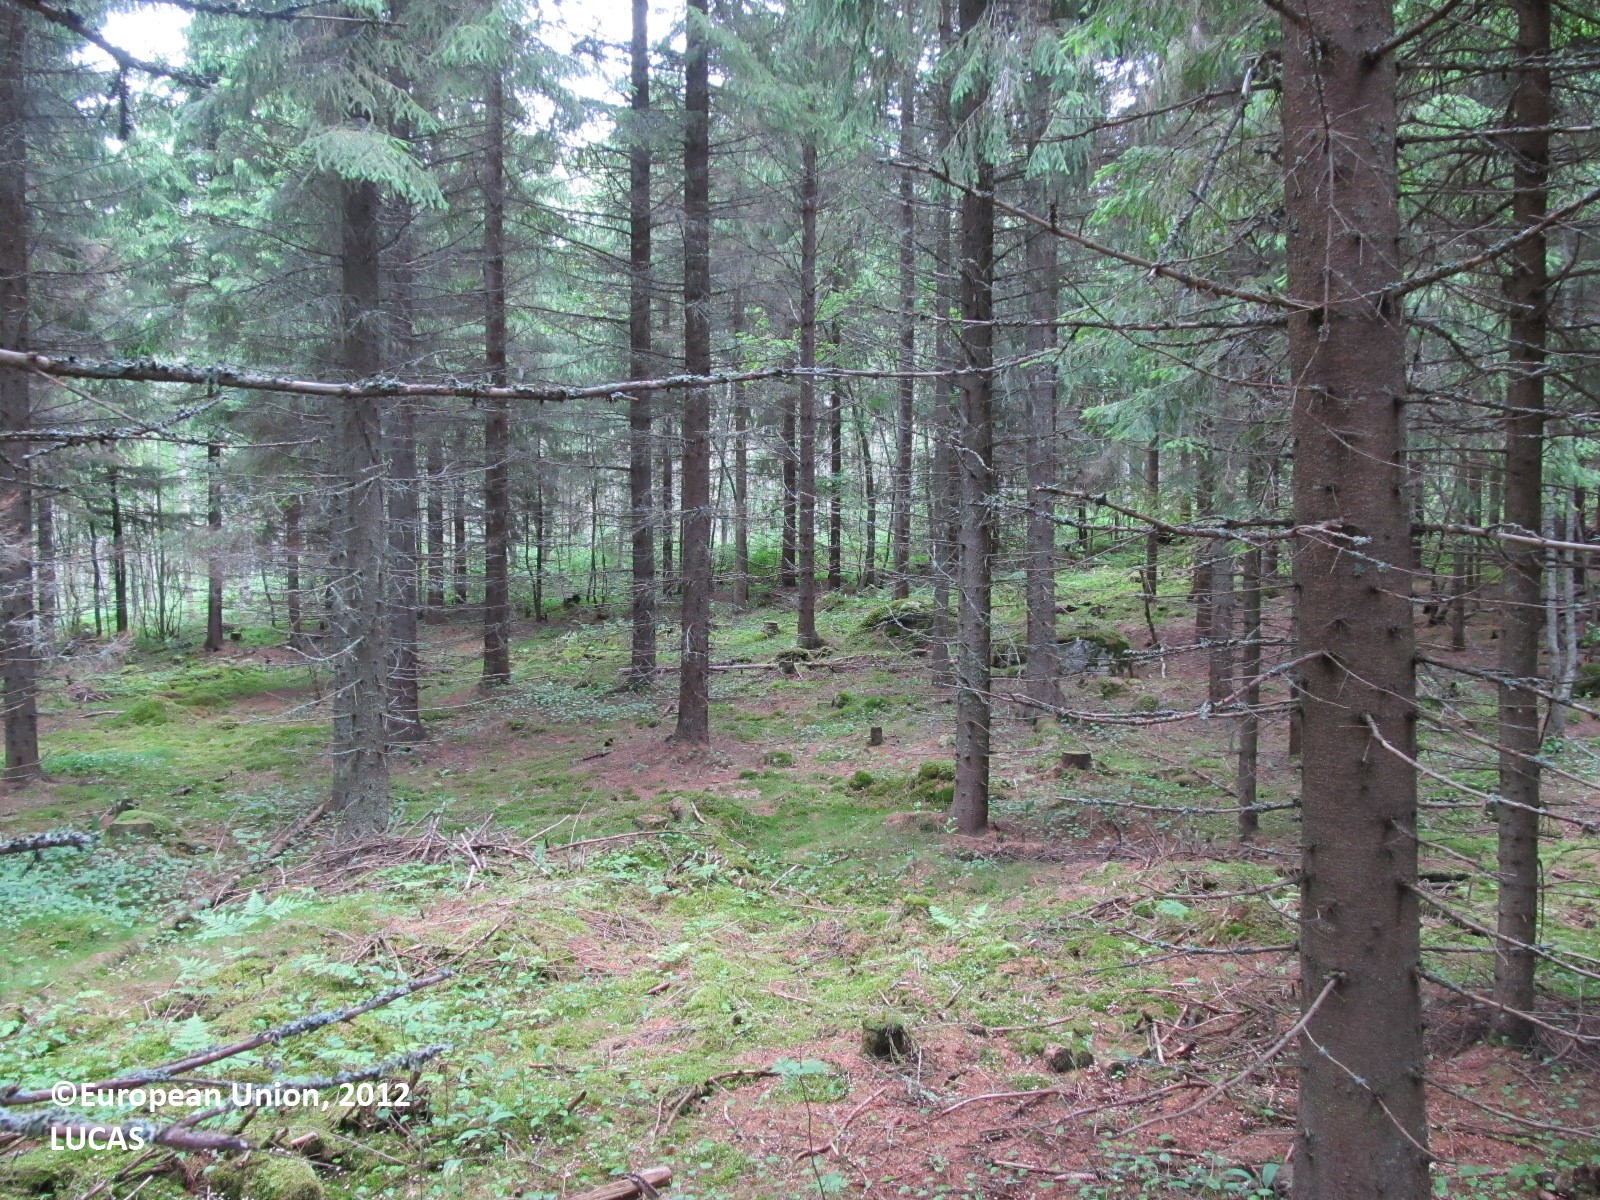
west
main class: Woodland
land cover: Spruce dominated coniferous woodland
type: boreal forest
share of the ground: 50 - 75 %
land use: Forestry
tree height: > 5 m
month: June
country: FI
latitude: 62.7587
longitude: 28.7519
